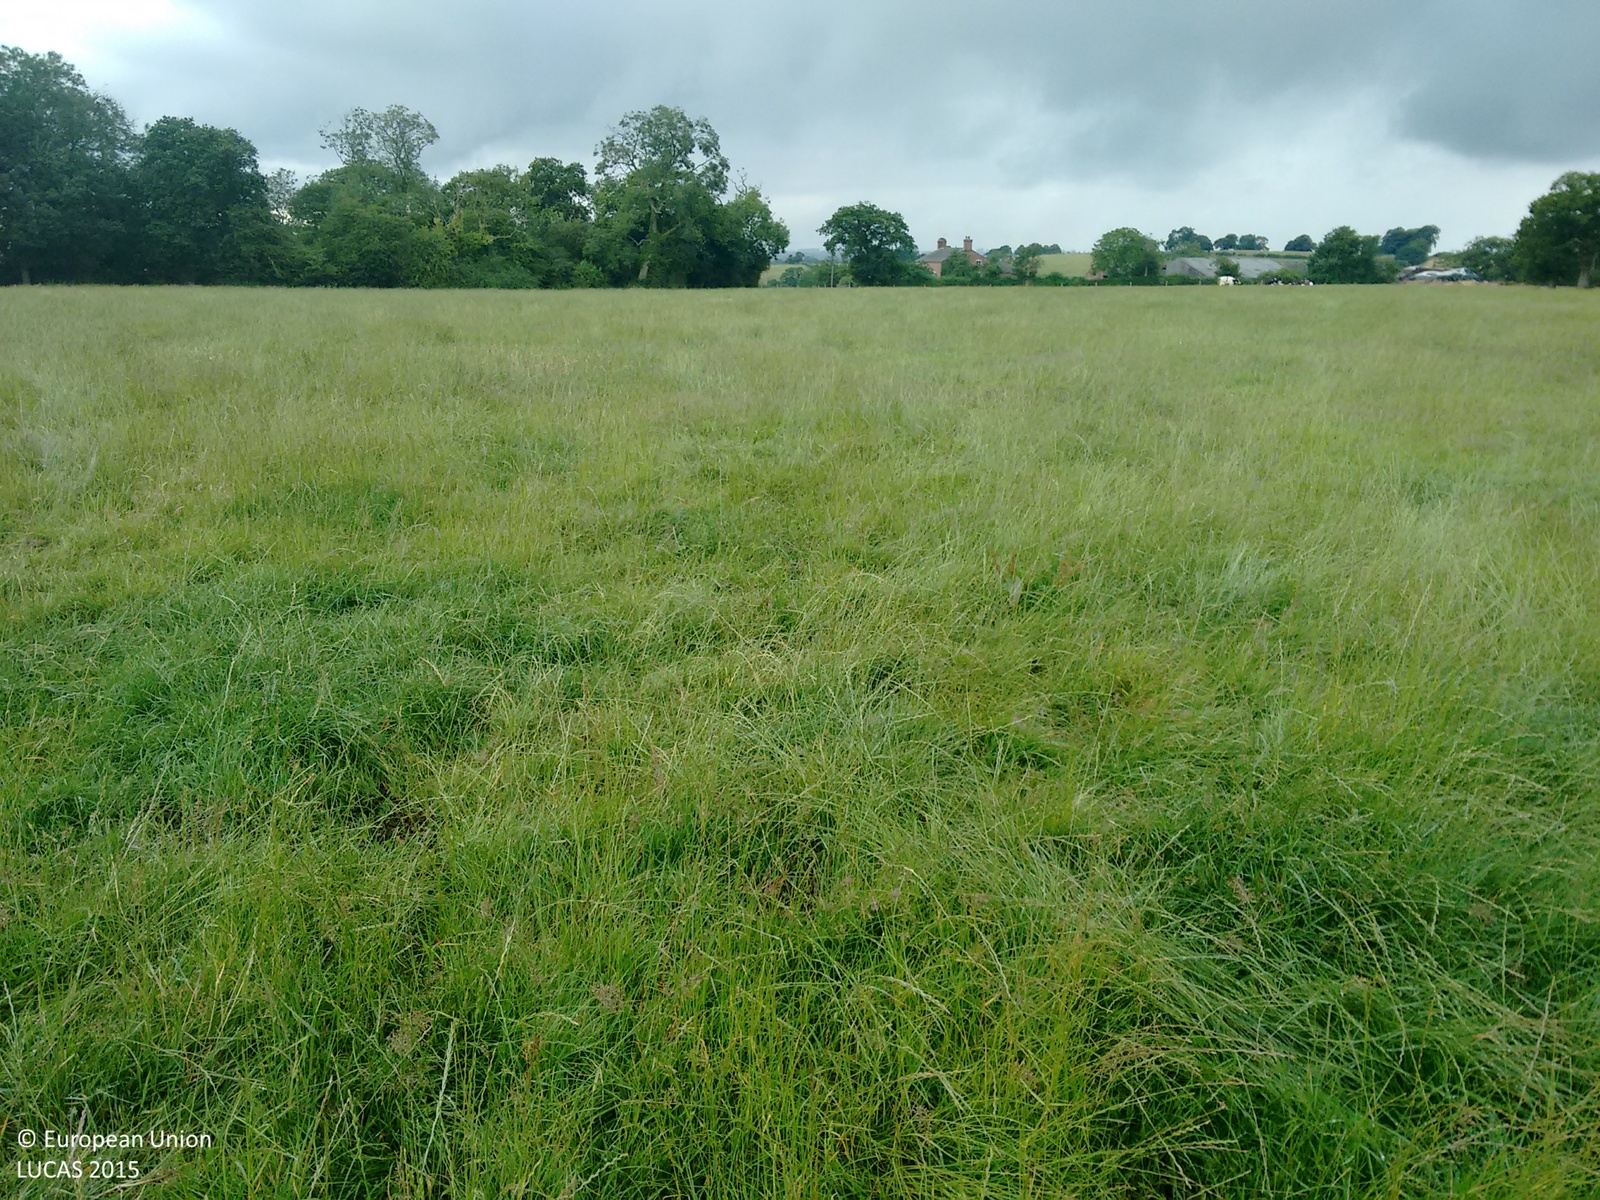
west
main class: Grassland
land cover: Grassland without tree/shrub cover
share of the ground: > 75 %
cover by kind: herbaceous plants 100 %
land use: Agriculture (excluding fallow land and kitchen gardens)
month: July
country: GB
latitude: 52.9672
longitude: -2.3471
